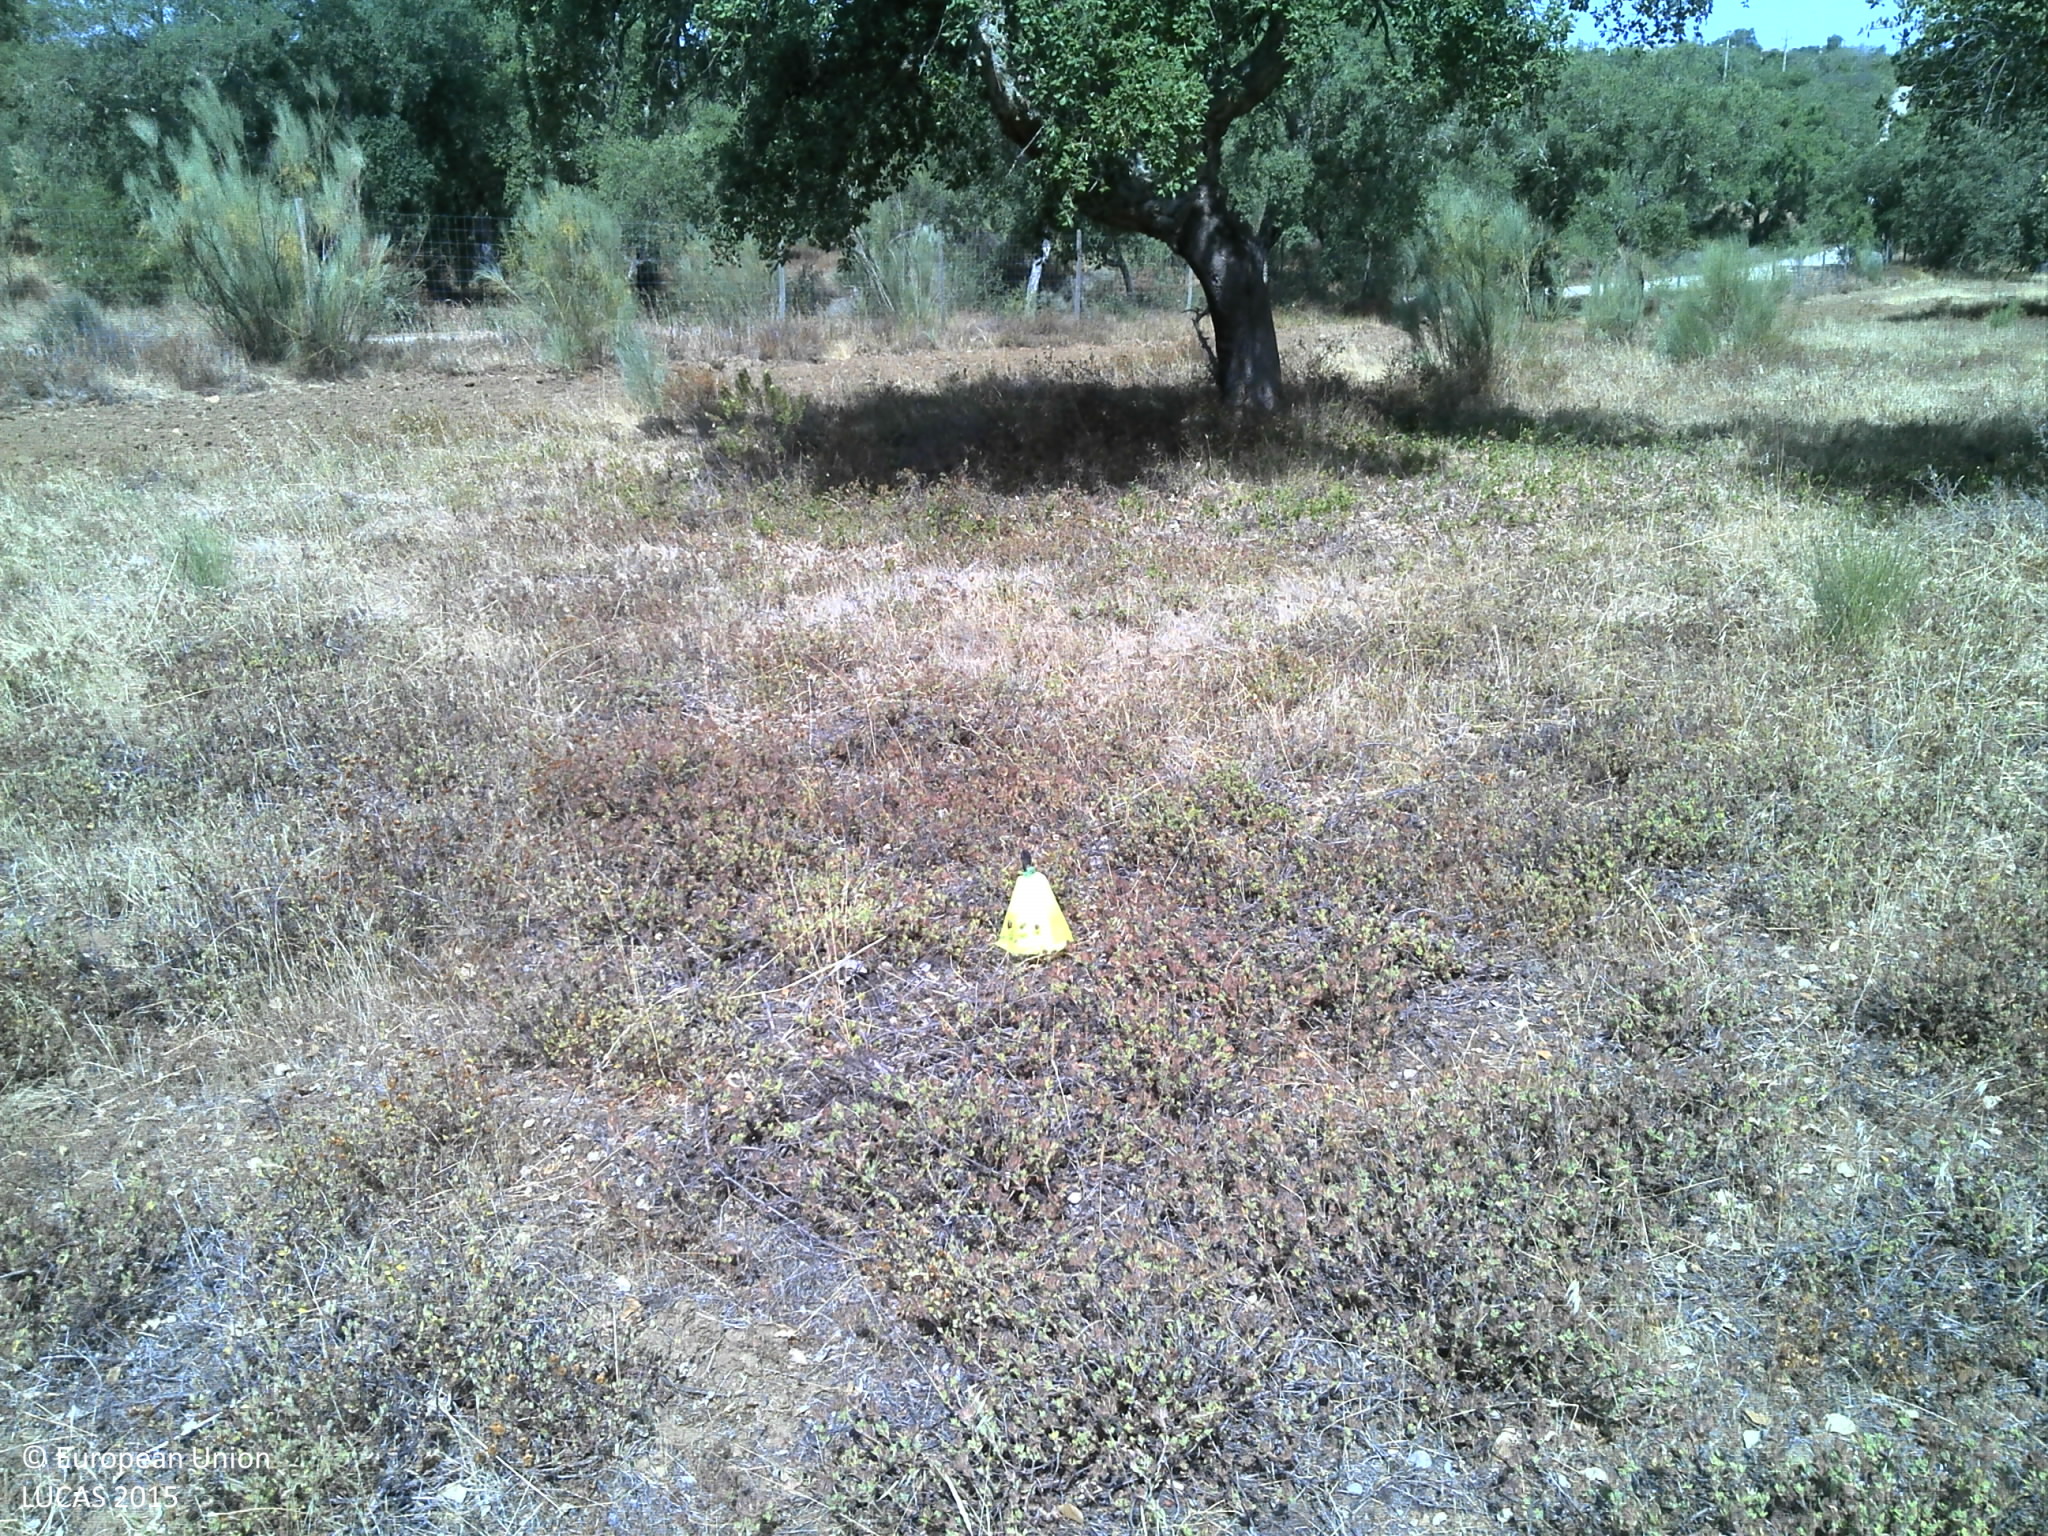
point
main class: Woodland
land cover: Broadleaved woodland
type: broadleaved evergreen forest
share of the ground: 10 - 25 %
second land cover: Grassland without tree/shrub cover
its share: 10 - 25 %
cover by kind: unconsolidated bare surface 70 %, broadleaved forest trees 15 %, herbaceous plants 15 %
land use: Forestry
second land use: Agriculture (excluding fallow land and kitchen gardens)
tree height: > 5 m
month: July
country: PT
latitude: 38.7247
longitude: -7.8582
